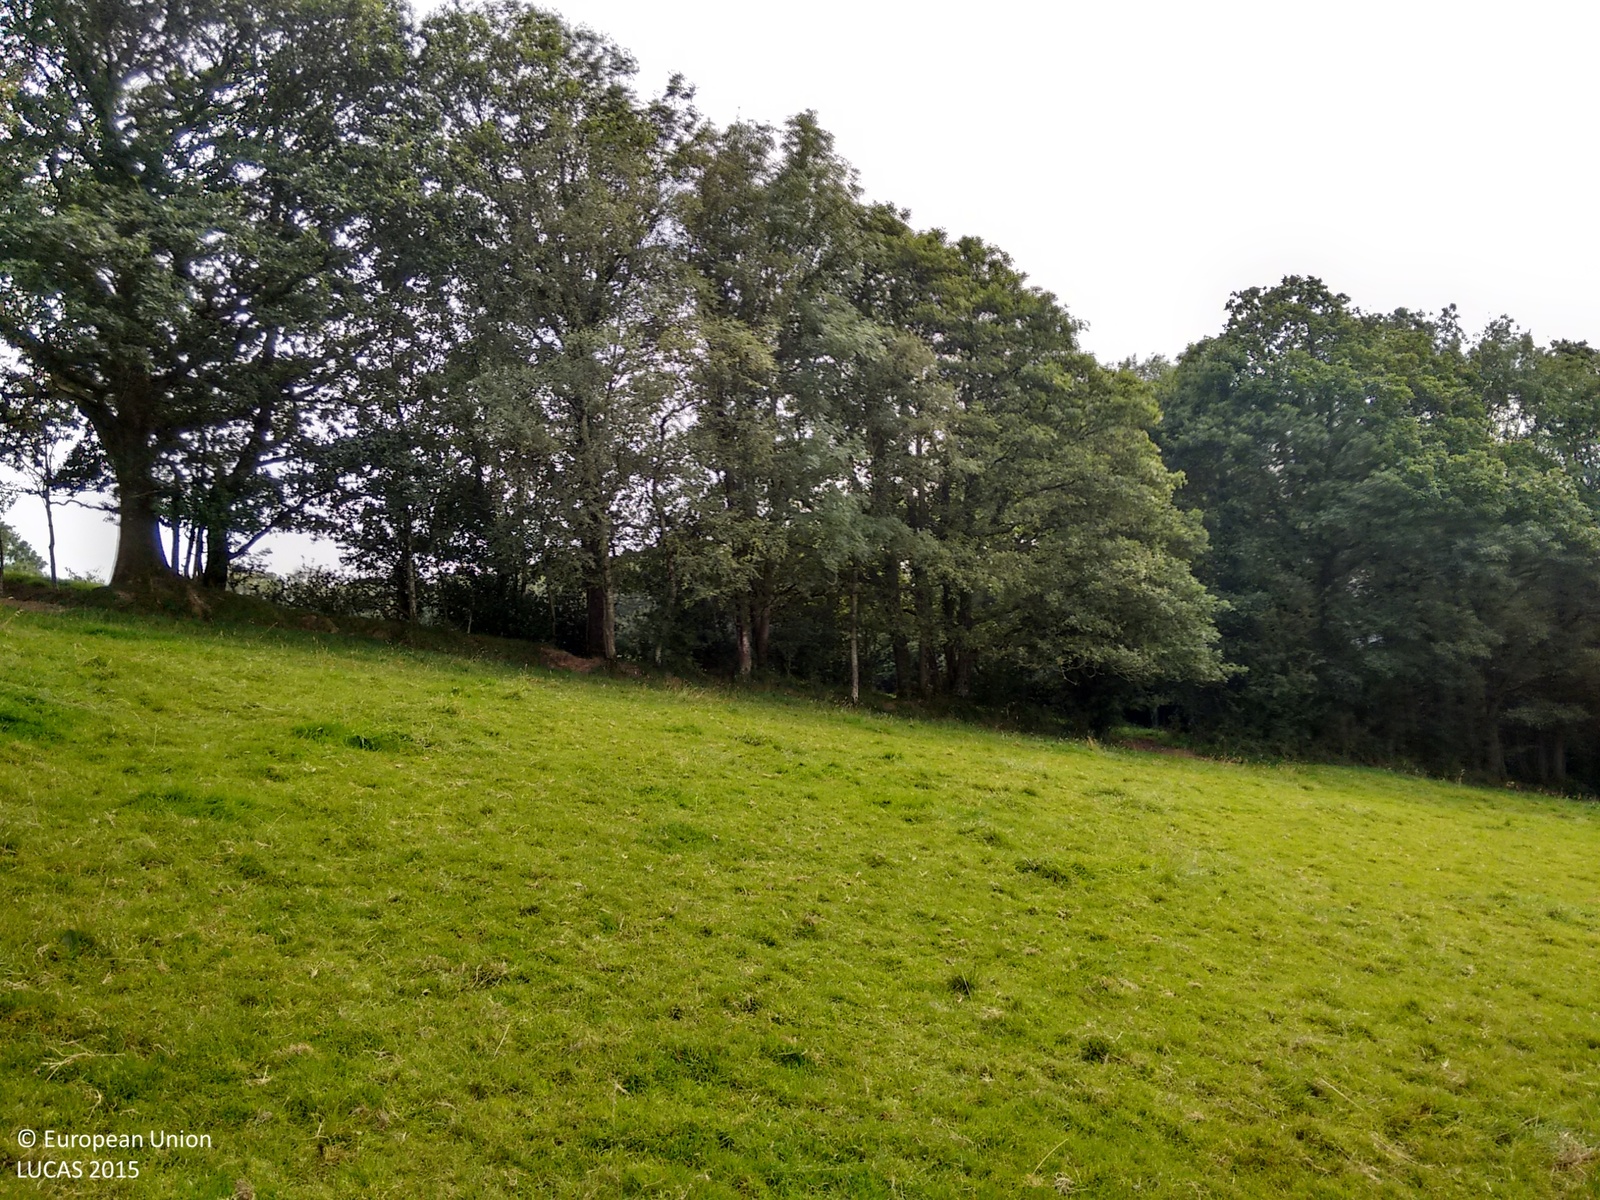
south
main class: Grassland
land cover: Grassland without tree/shrub cover
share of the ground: > 75 %
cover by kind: herbaceous plants 100 %
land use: Agriculture (excluding fallow land and kitchen gardens)
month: September
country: IE
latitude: 54.4124
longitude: -7.0124
